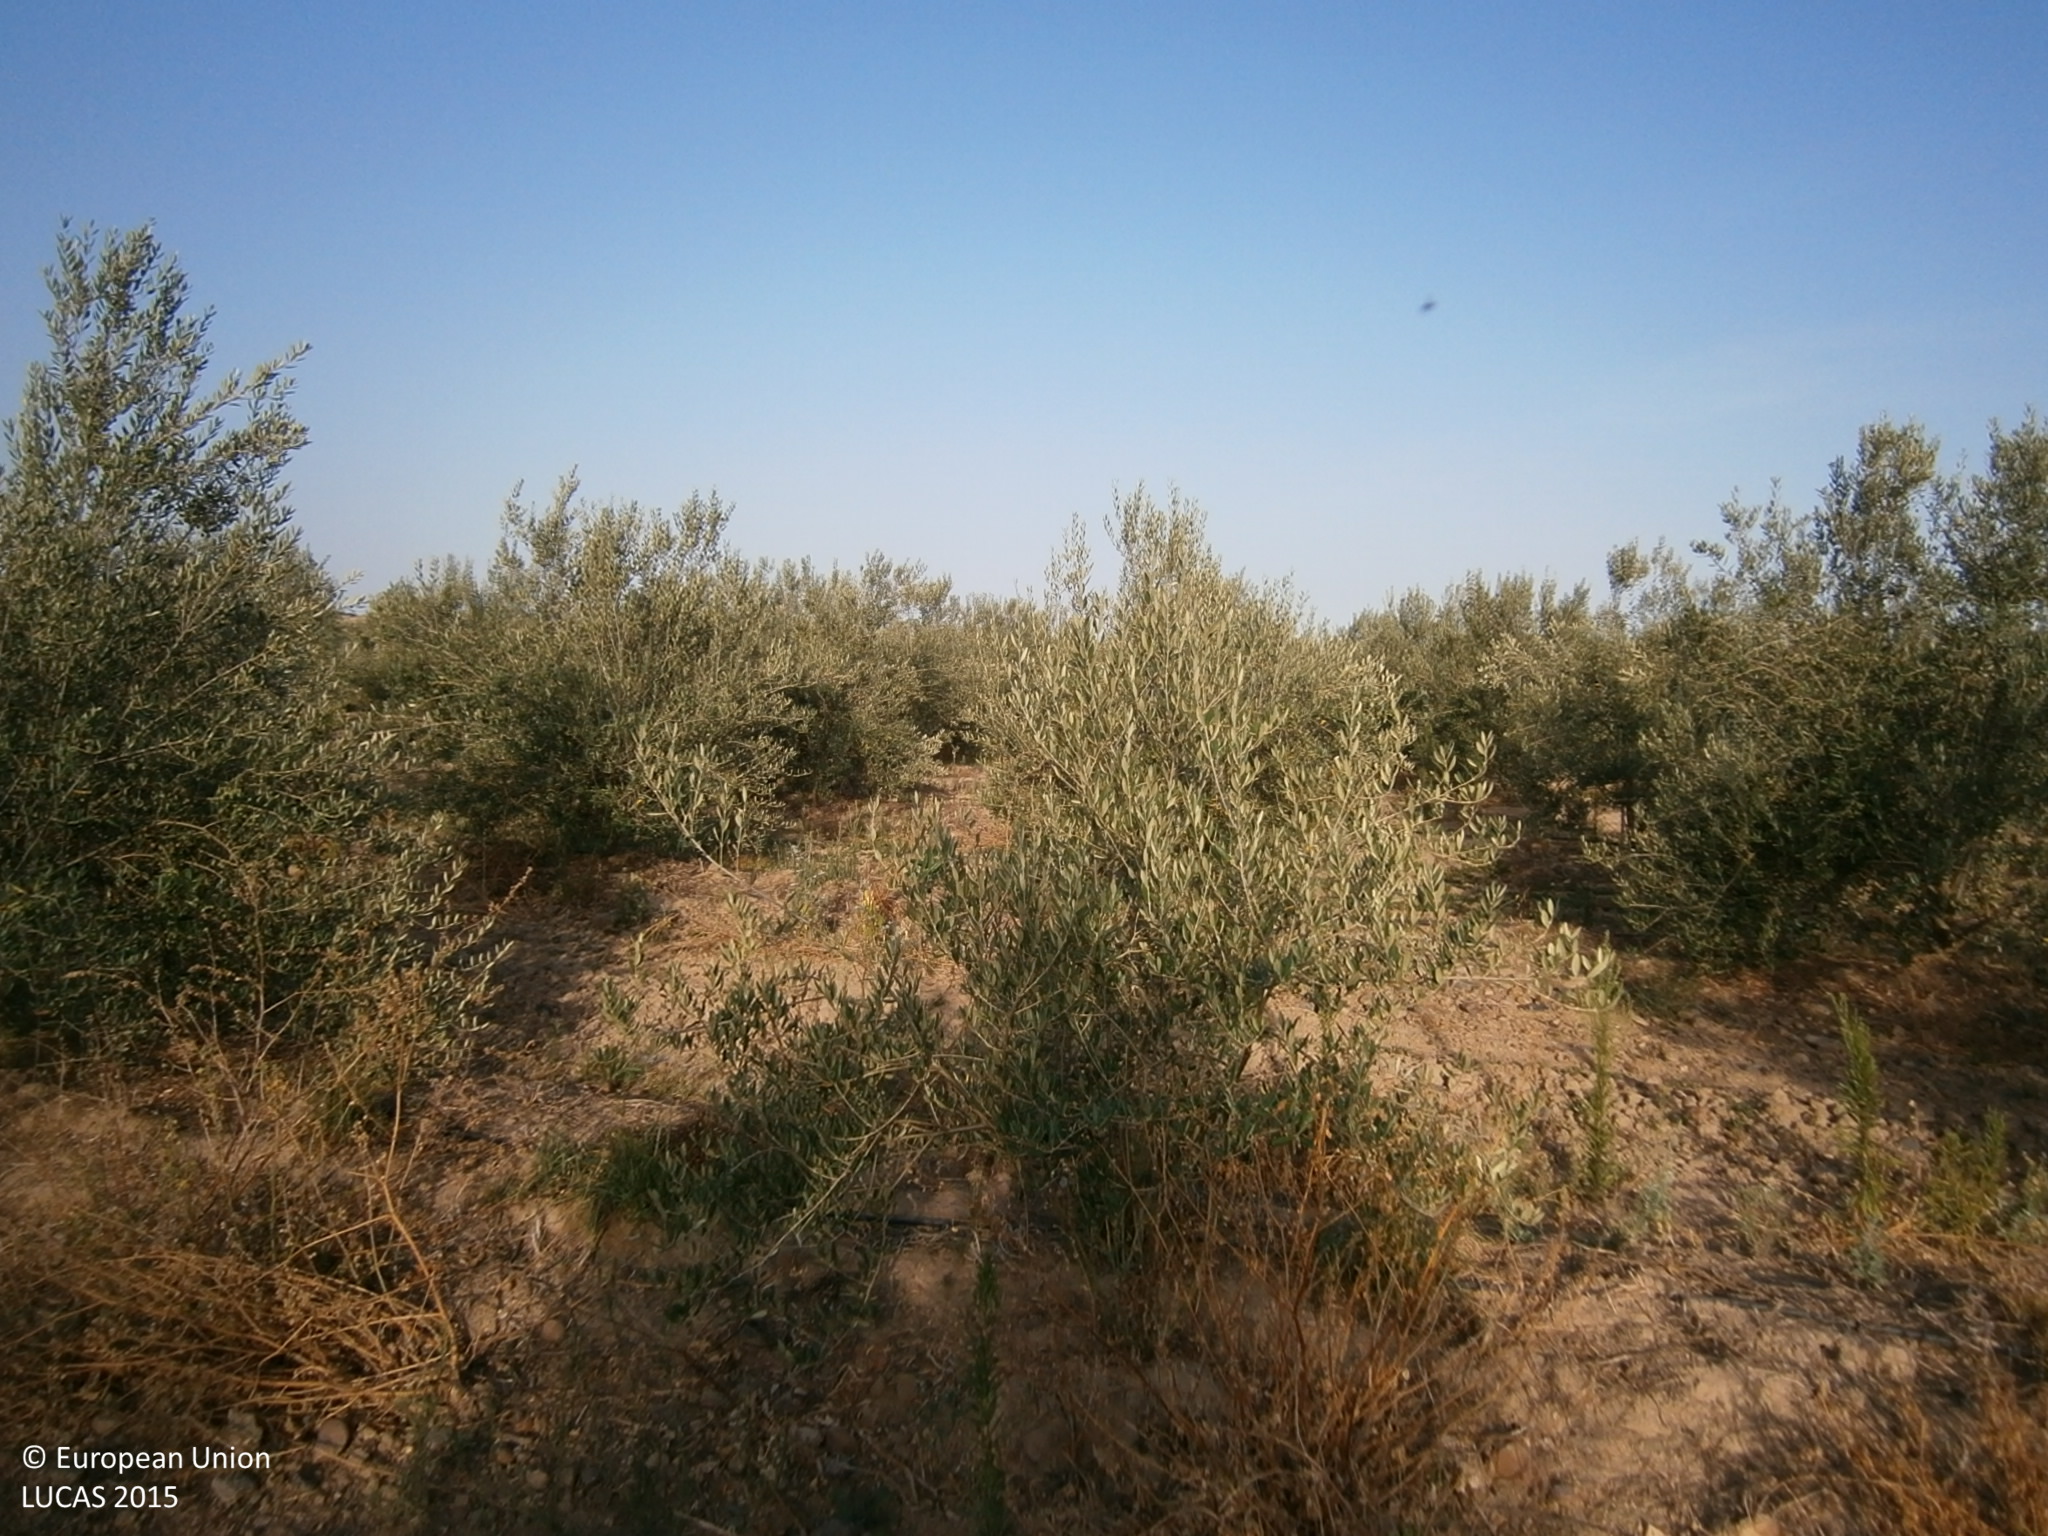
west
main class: Cropland
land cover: Olive groves
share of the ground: 25 - 50 %
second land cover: Spontaneously vegetated surfaces
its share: 25 - 50 %
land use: Agriculture (excluding fallow land and kitchen gardens)
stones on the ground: 10 - 25 %
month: July
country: ES
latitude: 38.8820
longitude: -6.7926
